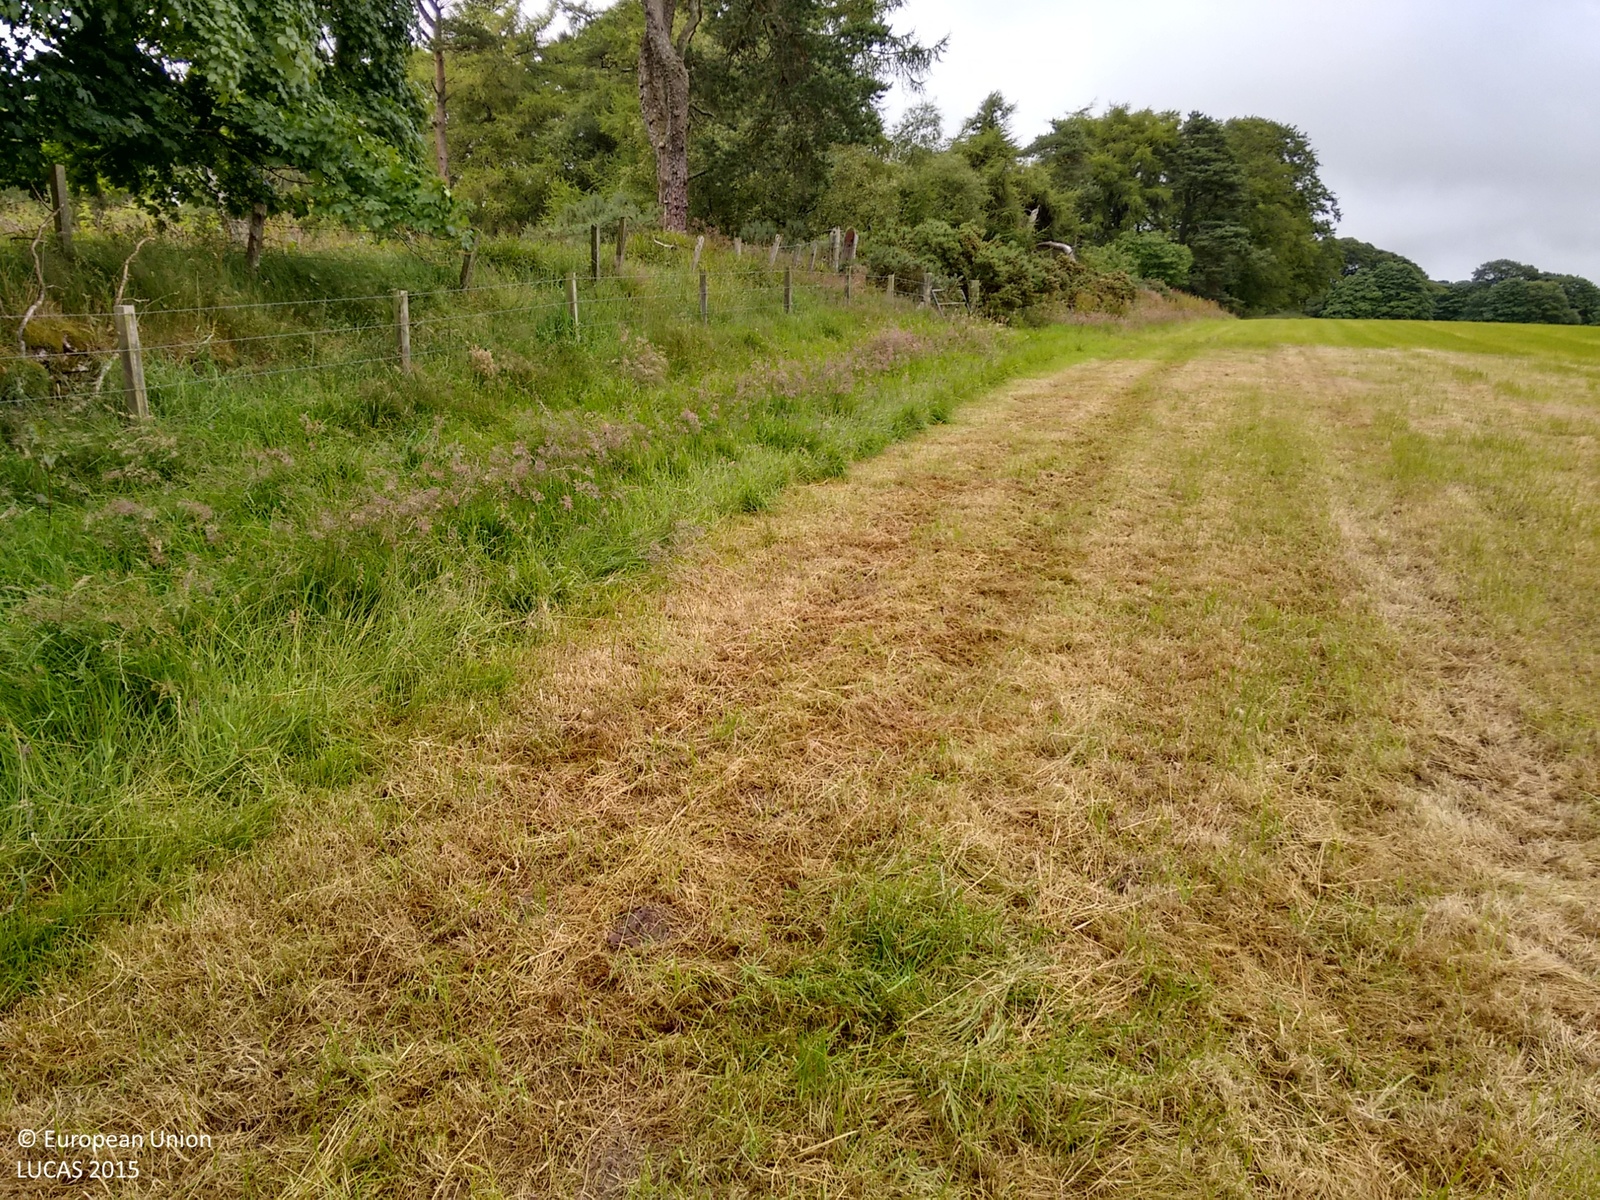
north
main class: Grassland
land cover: Grassland without tree/shrub cover
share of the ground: > 75 %
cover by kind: herbaceous plants 100 %
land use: Agriculture (excluding fallow land and kitchen gardens)
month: July
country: GB
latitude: 57.5960
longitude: -2.3132
